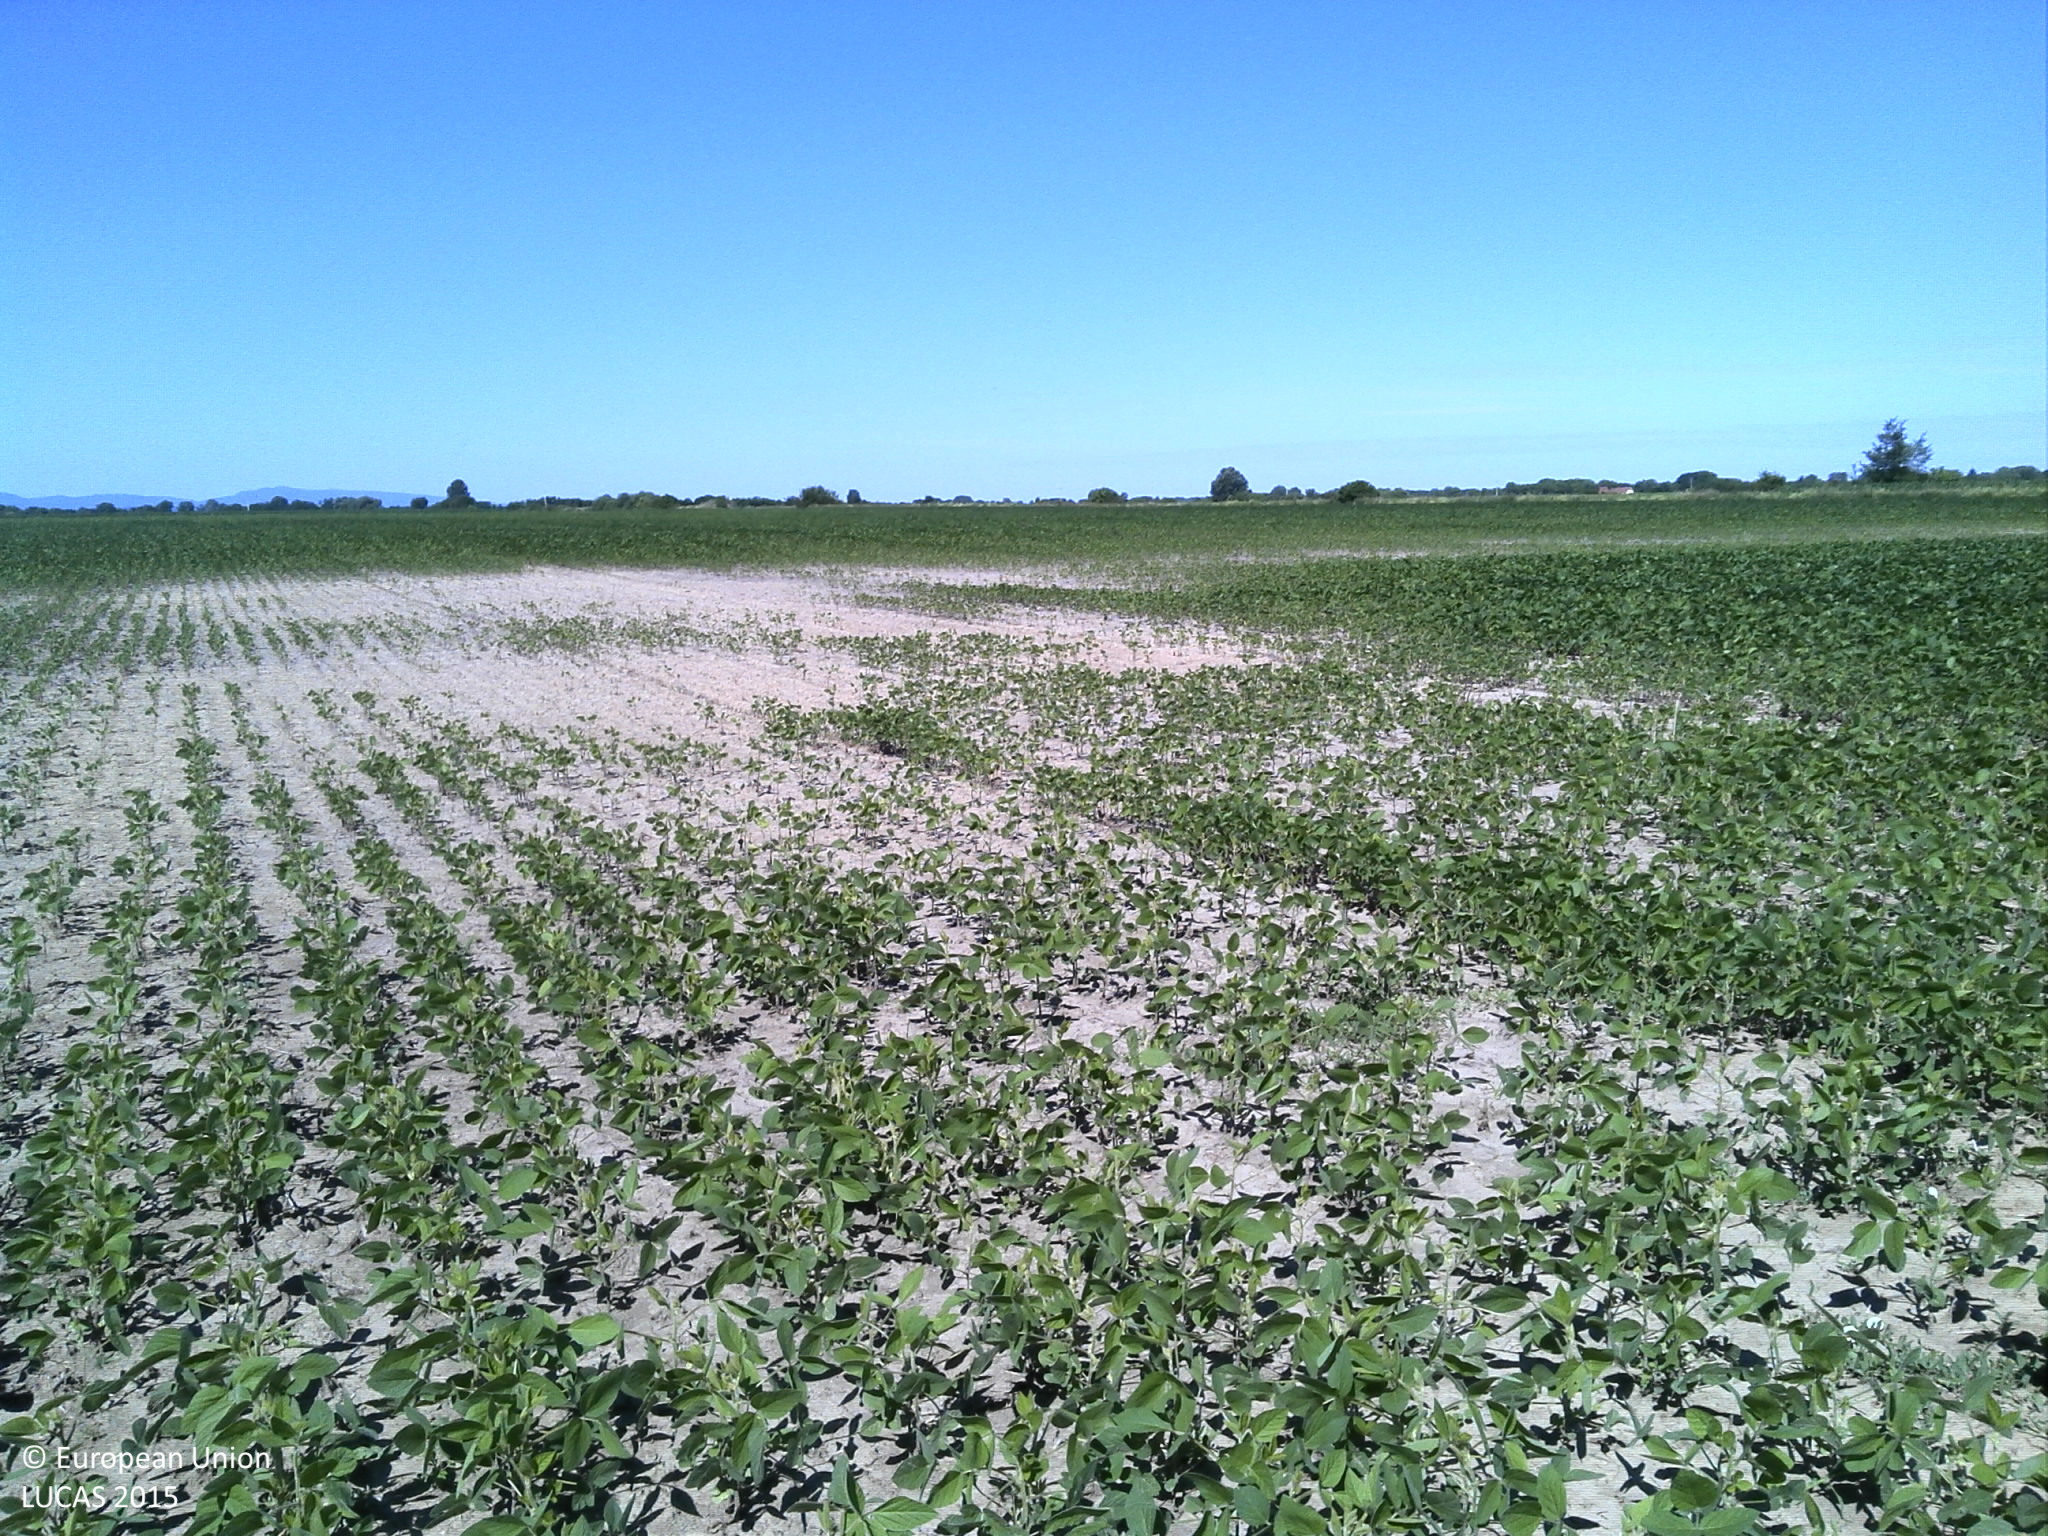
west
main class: Cropland
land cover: Soya
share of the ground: 50 - 75 %
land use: Agriculture (excluding fallow land and kitchen gardens)
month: June
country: HR
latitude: 45.7663
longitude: 17.9381
